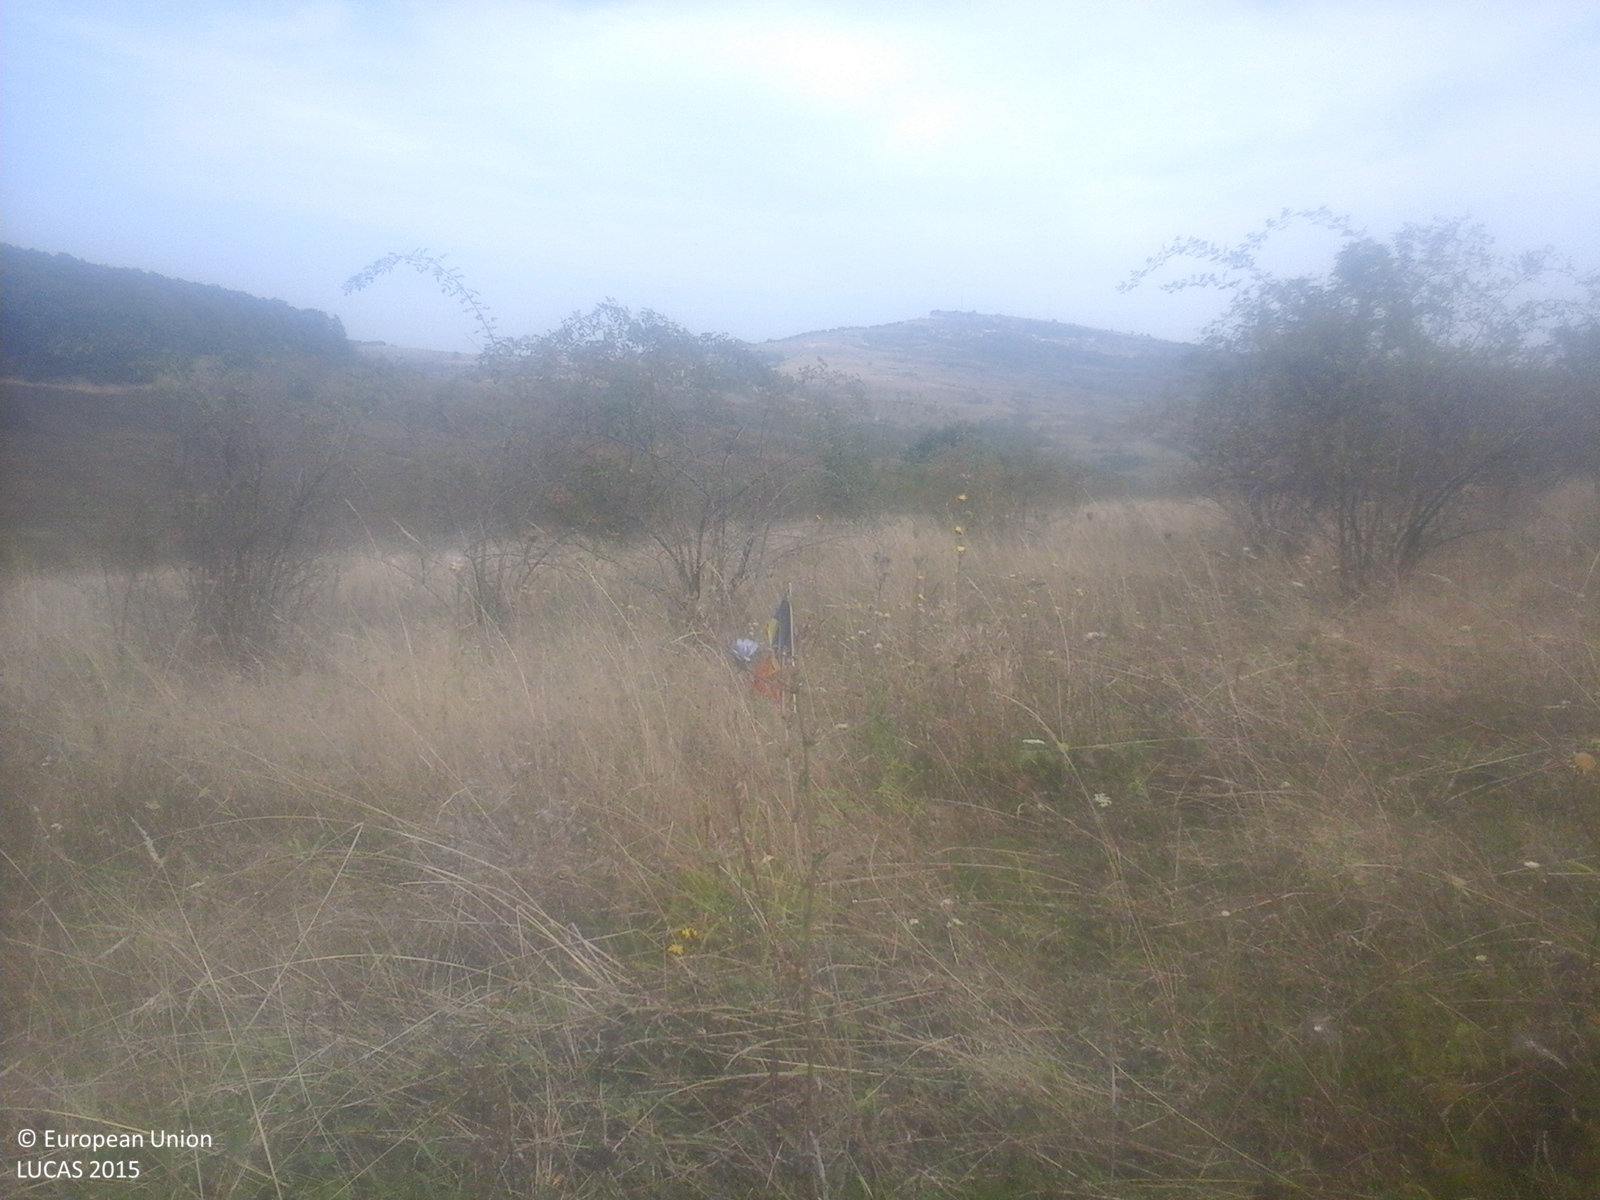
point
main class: Shrubland
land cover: Shrubland without tree cover
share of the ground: > 75 %
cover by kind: shrubs 60 %, herbaceous plants 40 %
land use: Fallow land
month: September
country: RO
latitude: 47.0805
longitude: 23.6265
